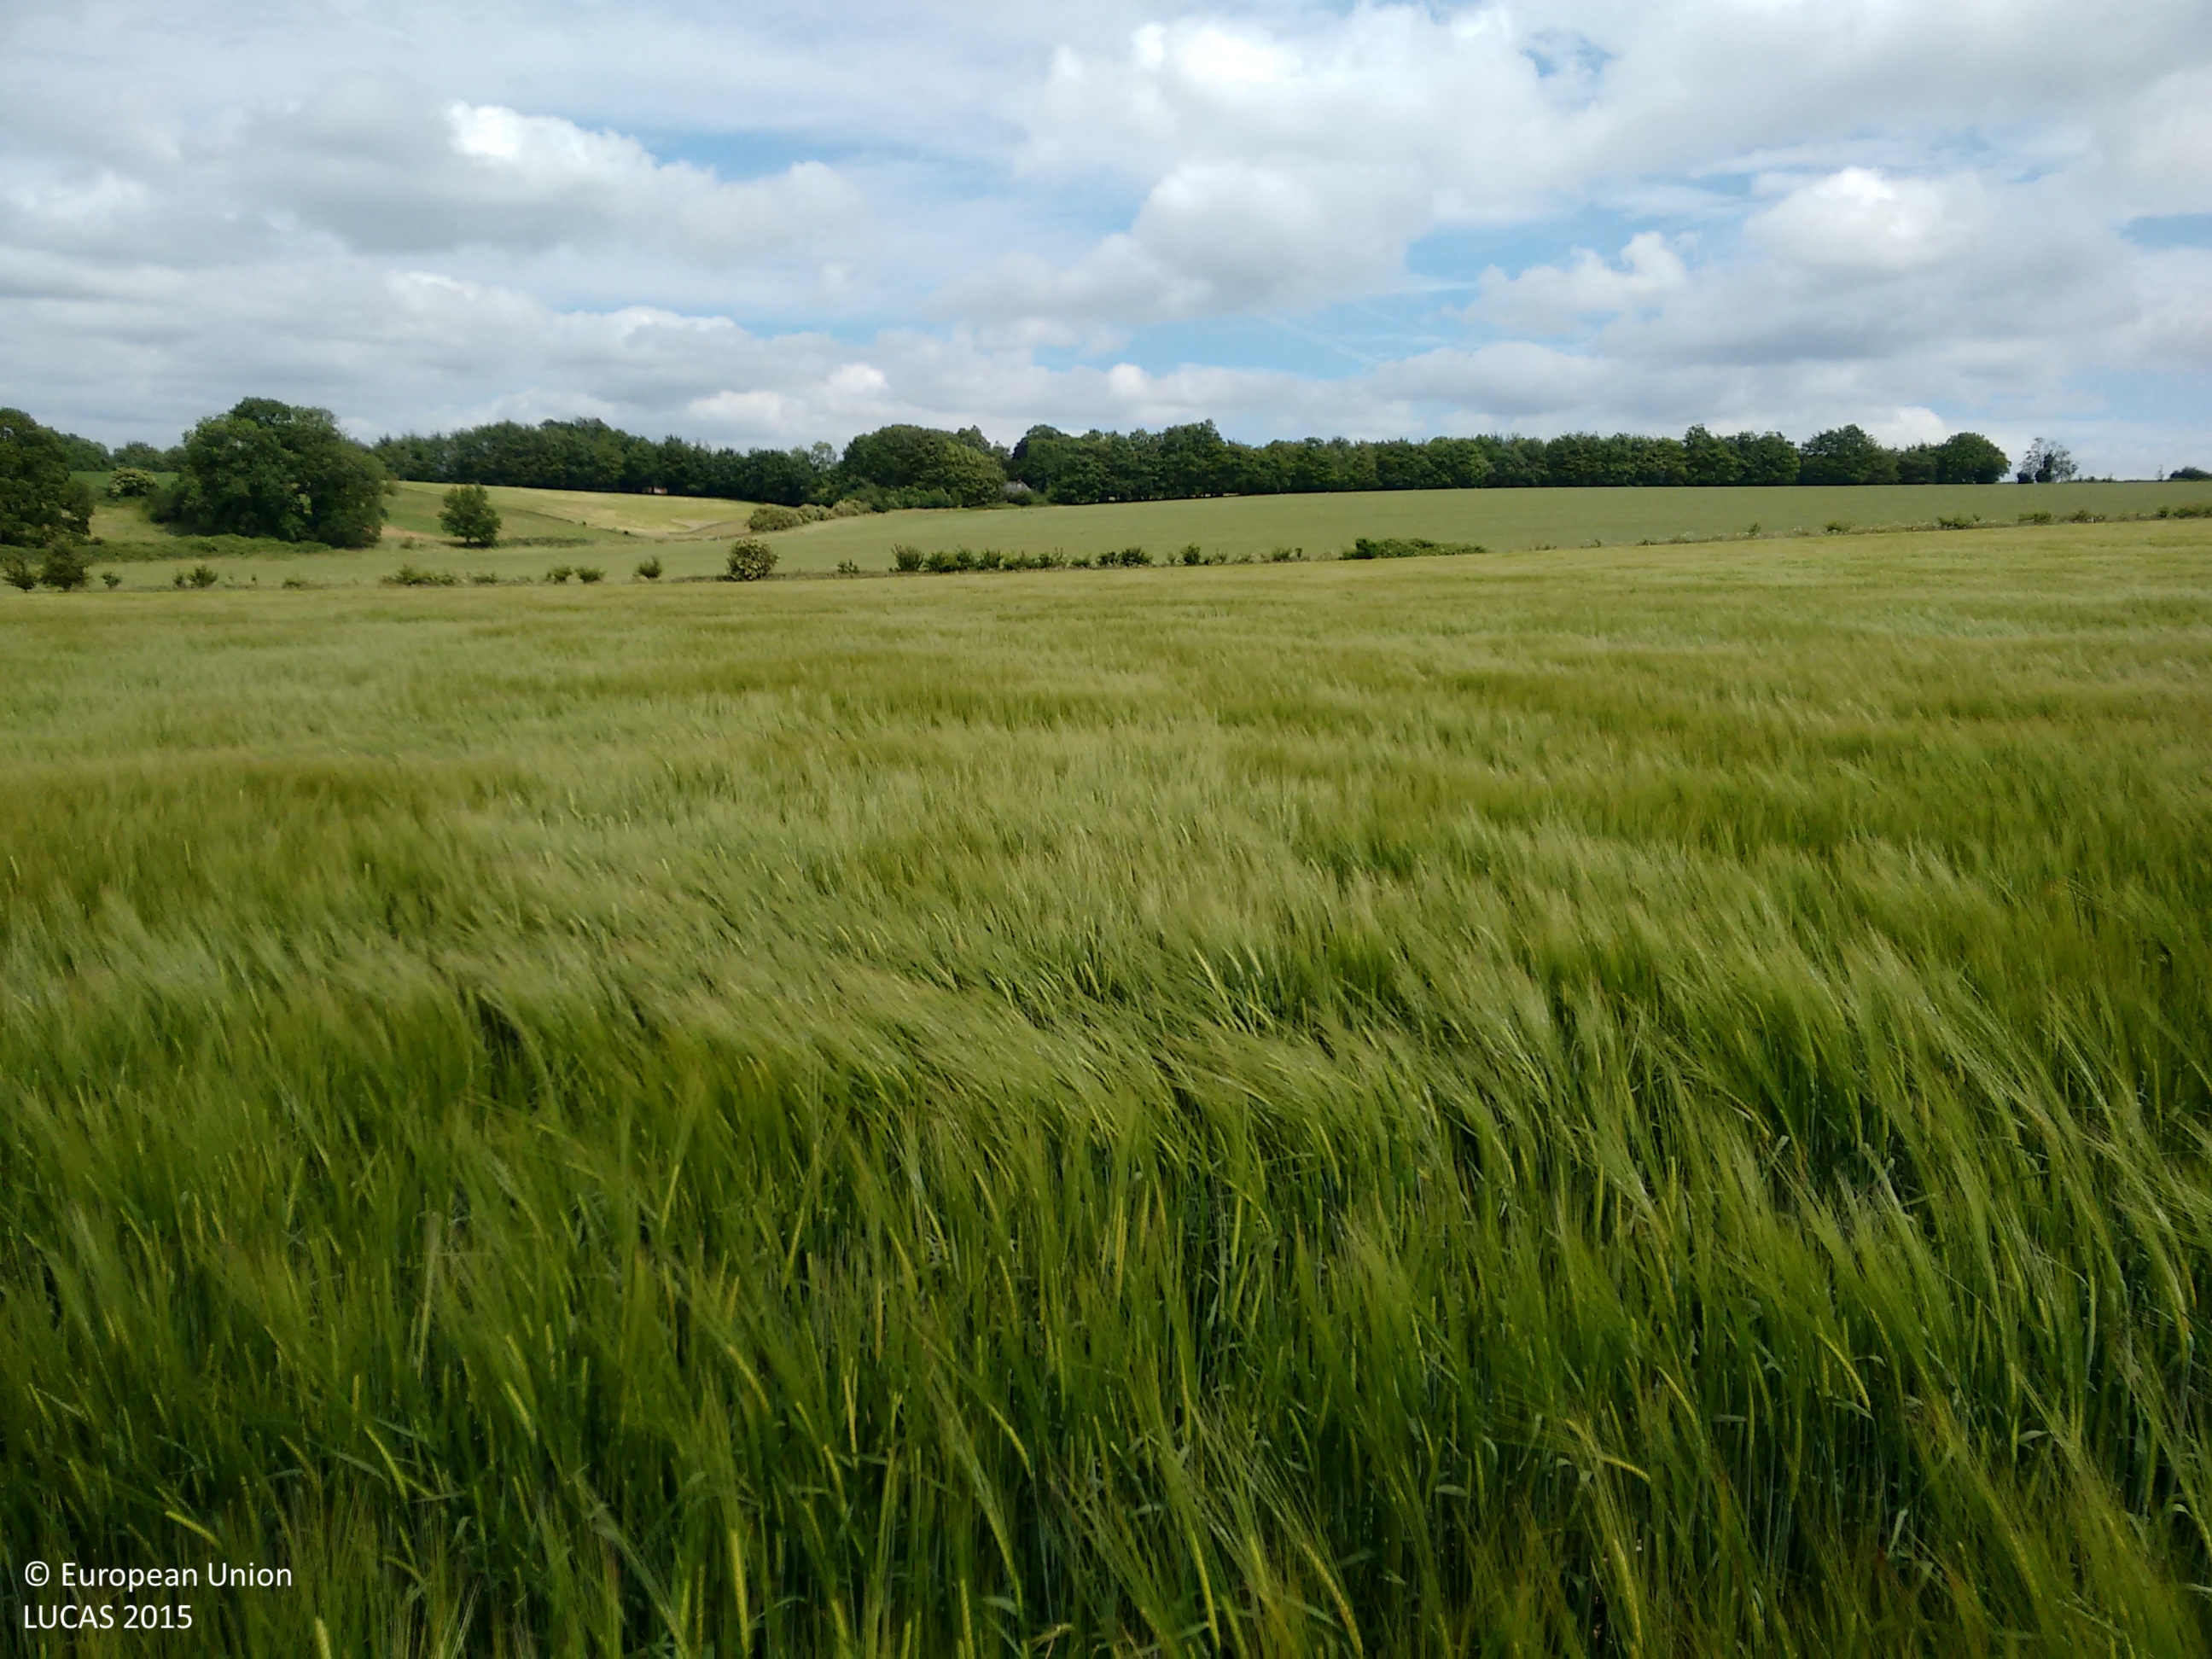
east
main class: Cropland
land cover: Barley
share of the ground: > 75 %
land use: Agriculture (excluding fallow land and kitchen gardens)
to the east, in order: Barley; Shruby margins; Fences; Managed hedges; Spontaneously vegetated surfaces; Common wheat
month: June
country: GB
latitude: 51.3774
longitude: -1.5307
